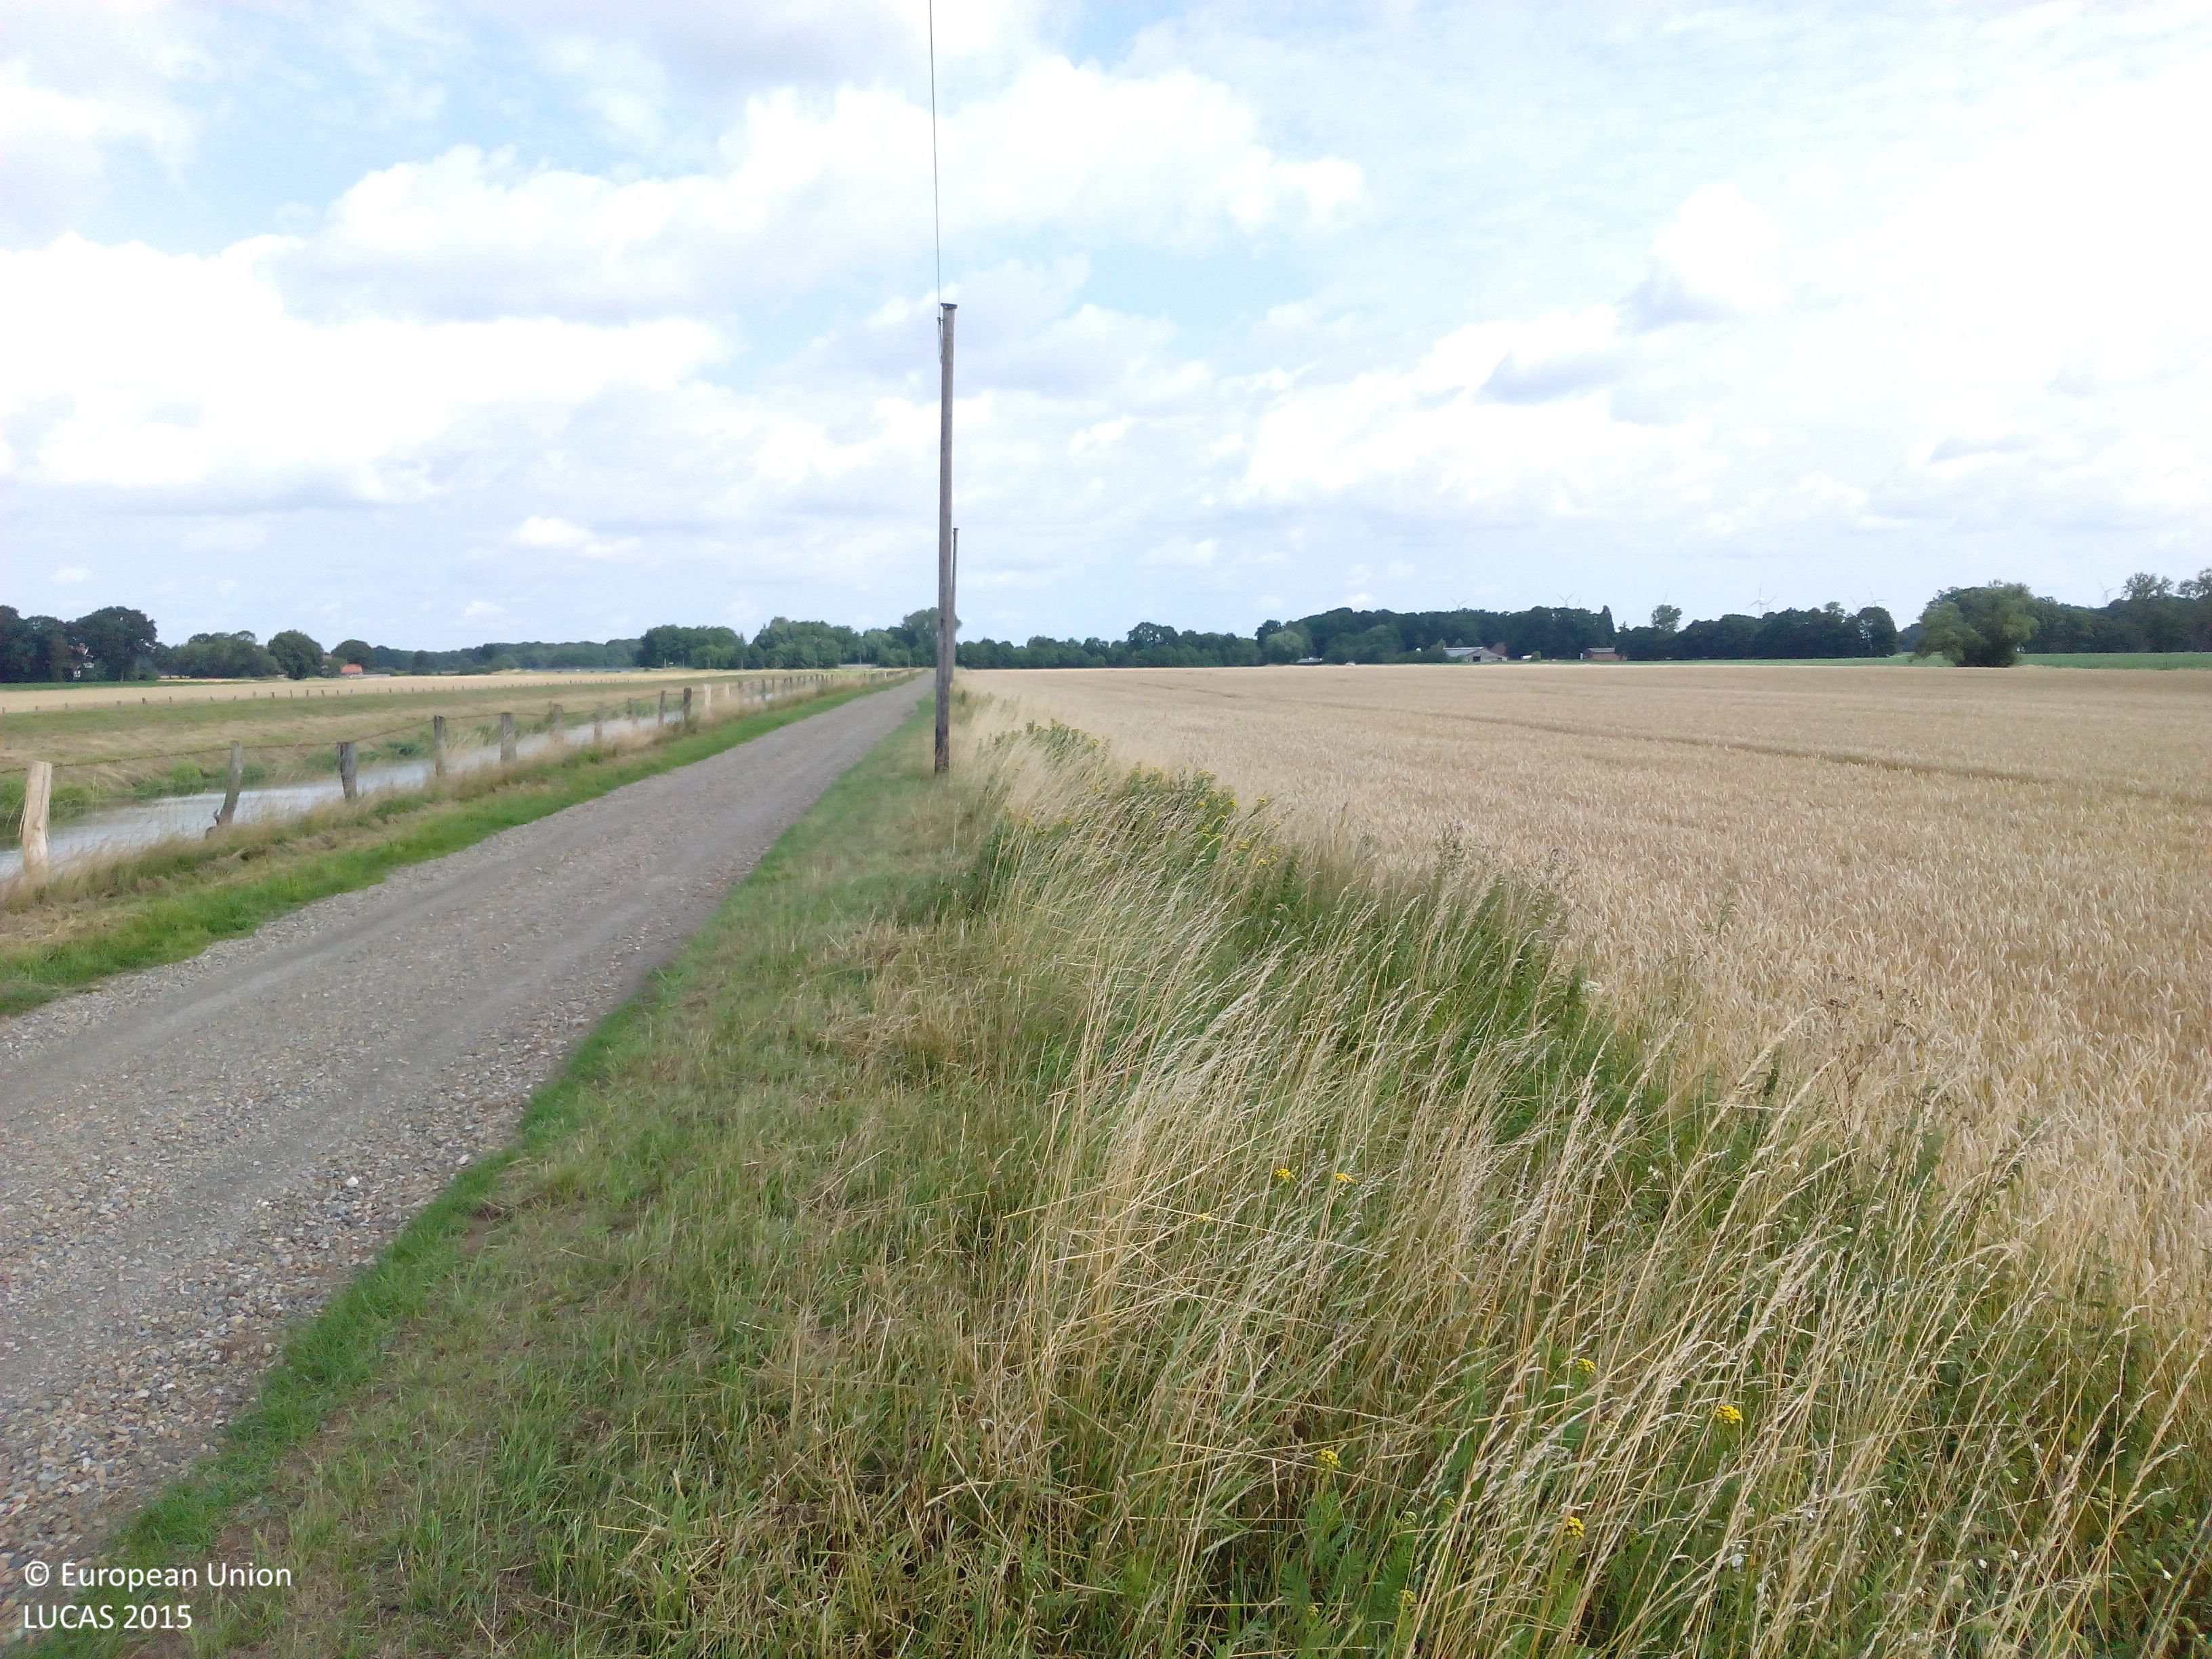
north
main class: Cropland
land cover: Common wheat
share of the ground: > 75 %
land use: Agriculture (excluding fallow land and kitchen gardens)
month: July
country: DE
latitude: 52.6304
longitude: 8.0059
